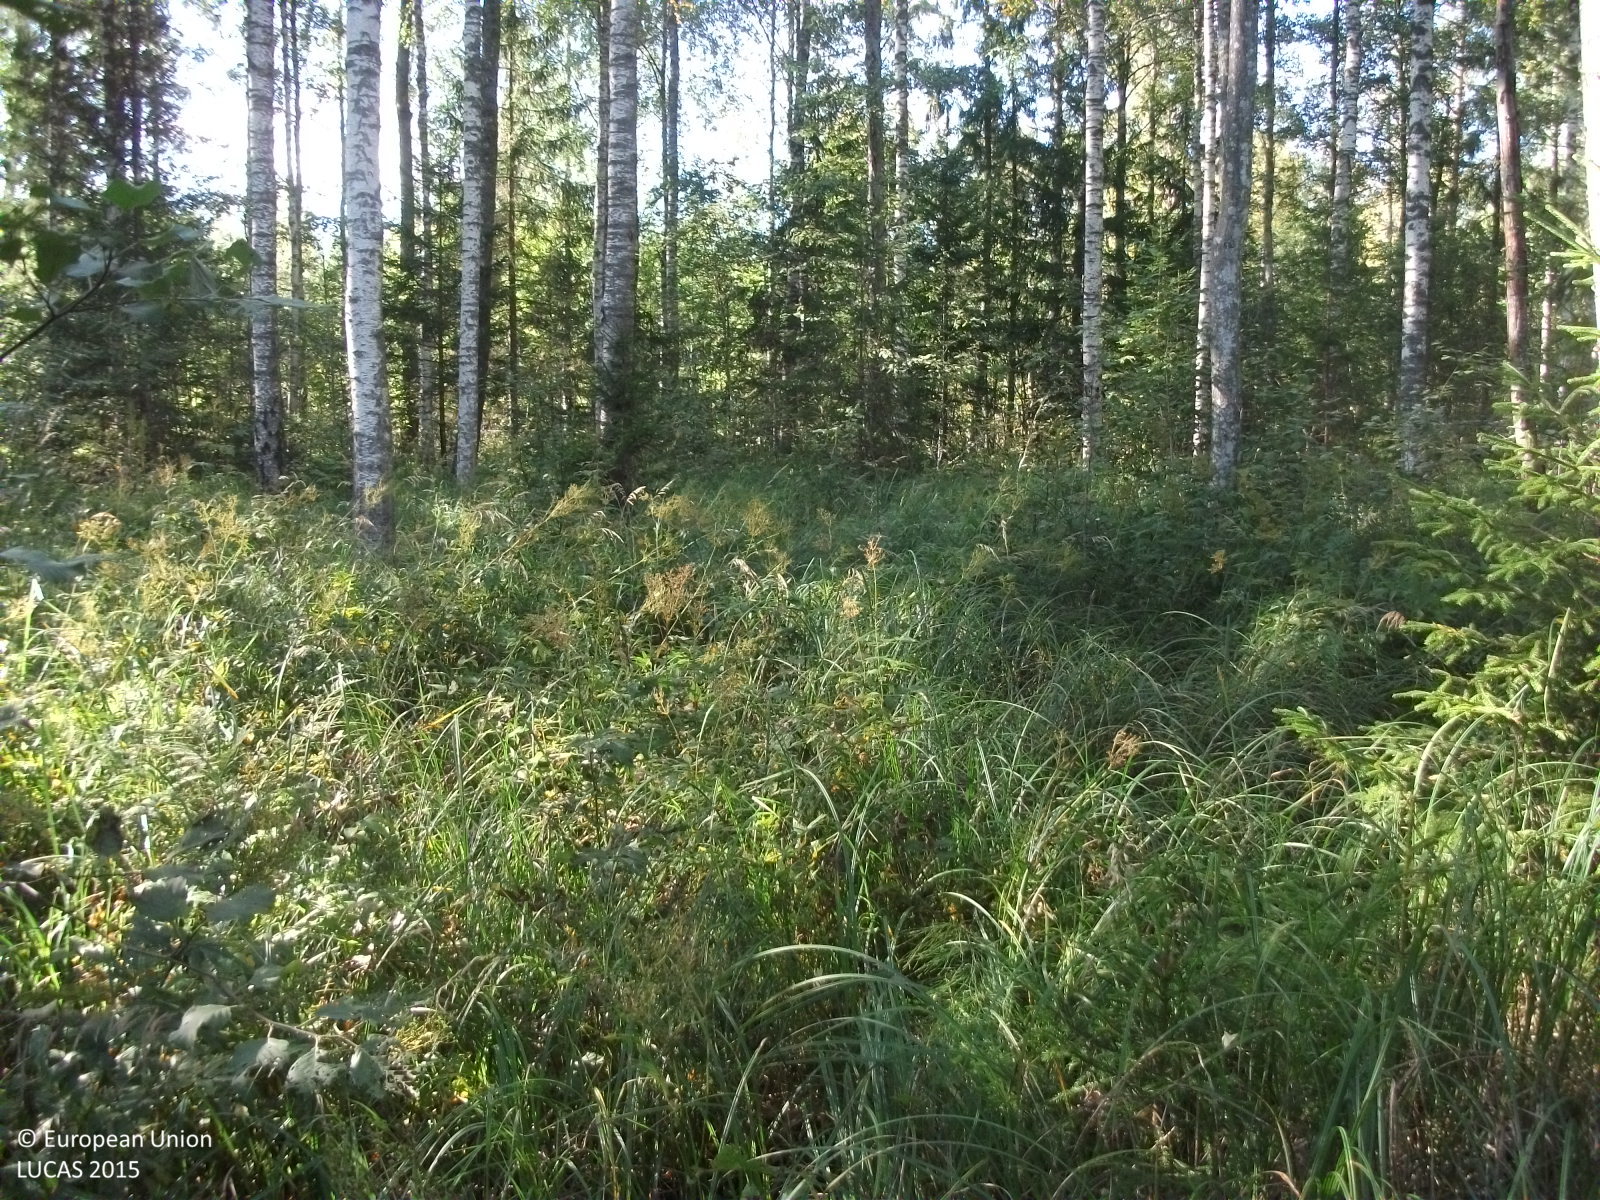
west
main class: Woodland
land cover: Spruce dominated mixed woodland
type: hemiboreal forest and nemoral coniferous forest and mixed broadleaved-coniferous forest
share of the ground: > 75 %
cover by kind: broadleaved forest trees 55 %, coniferous forest trees 30 %, herbaceous plants 10 %, shrubs 5 %
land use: Forestry
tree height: > 5 m
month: September
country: LV
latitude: 58.0116
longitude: 25.0106
